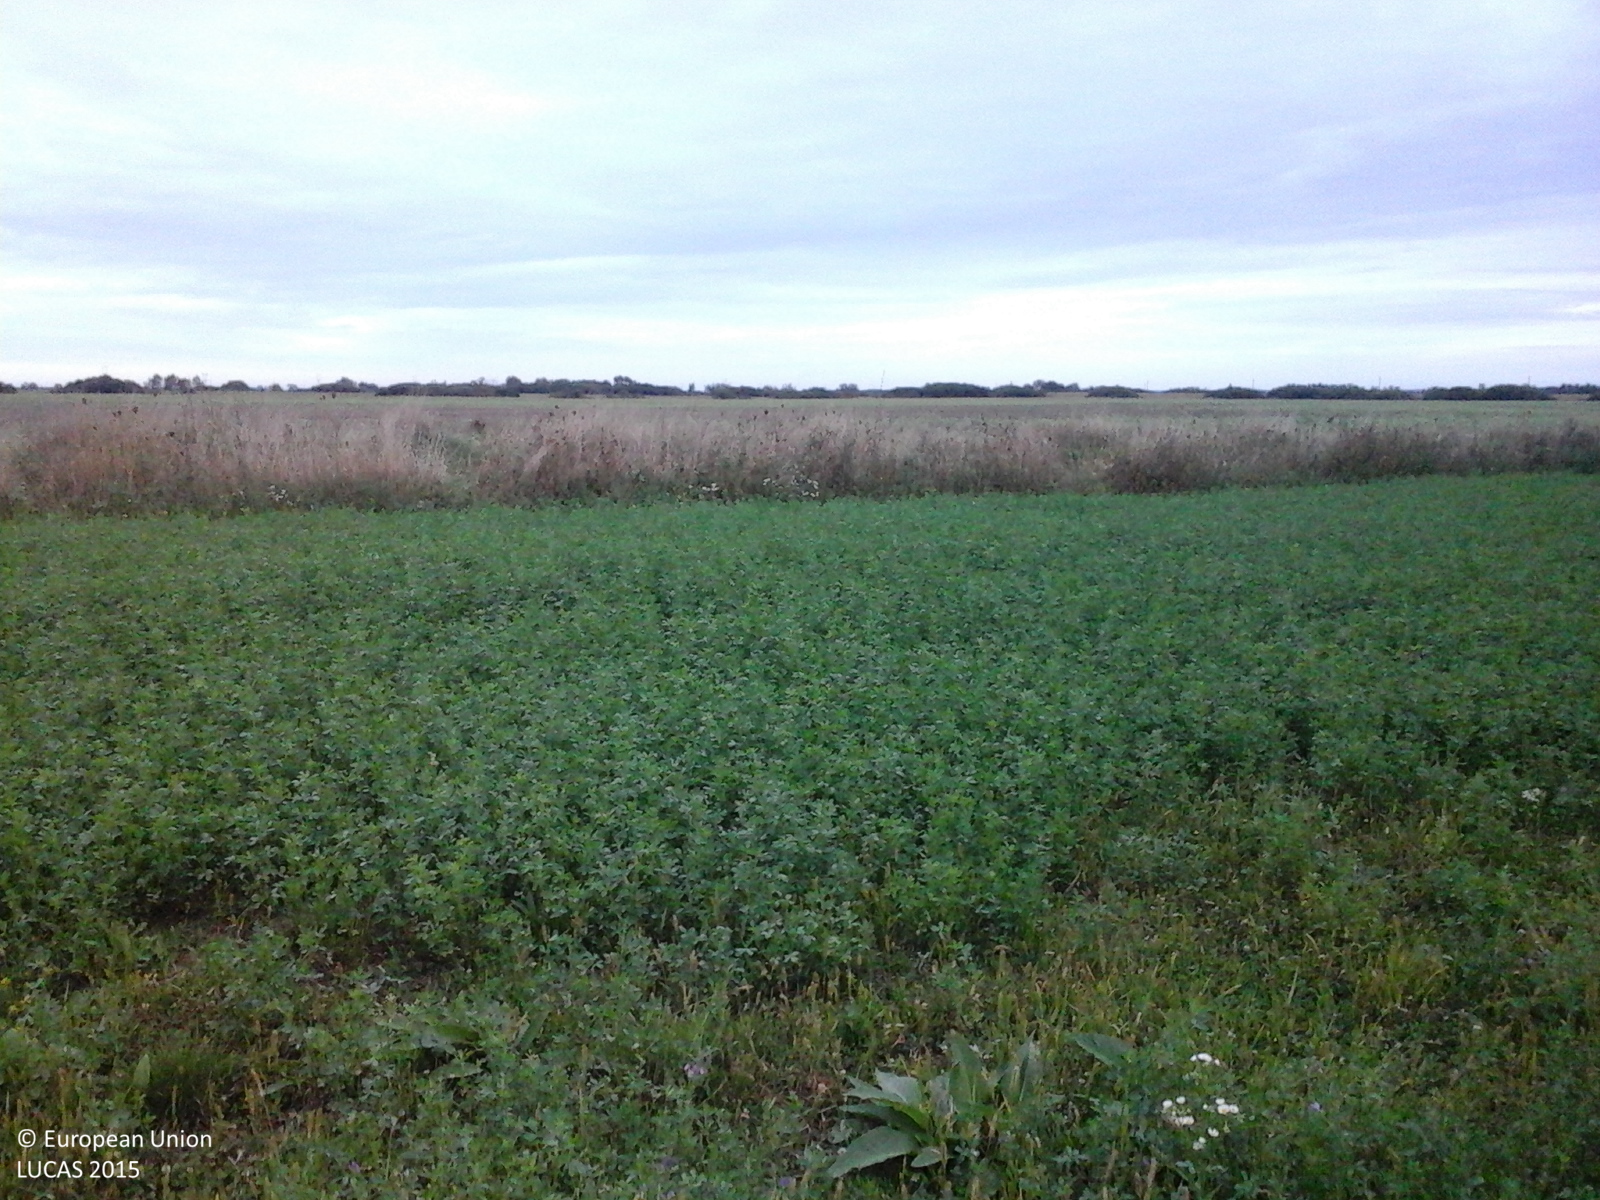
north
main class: Grassland
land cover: Spontaneously vegetated surfaces
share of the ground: > 75 %
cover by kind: herbaceous plants 100 %
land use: Fallow land
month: September
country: RO
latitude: 46.7963
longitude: 21.7156
